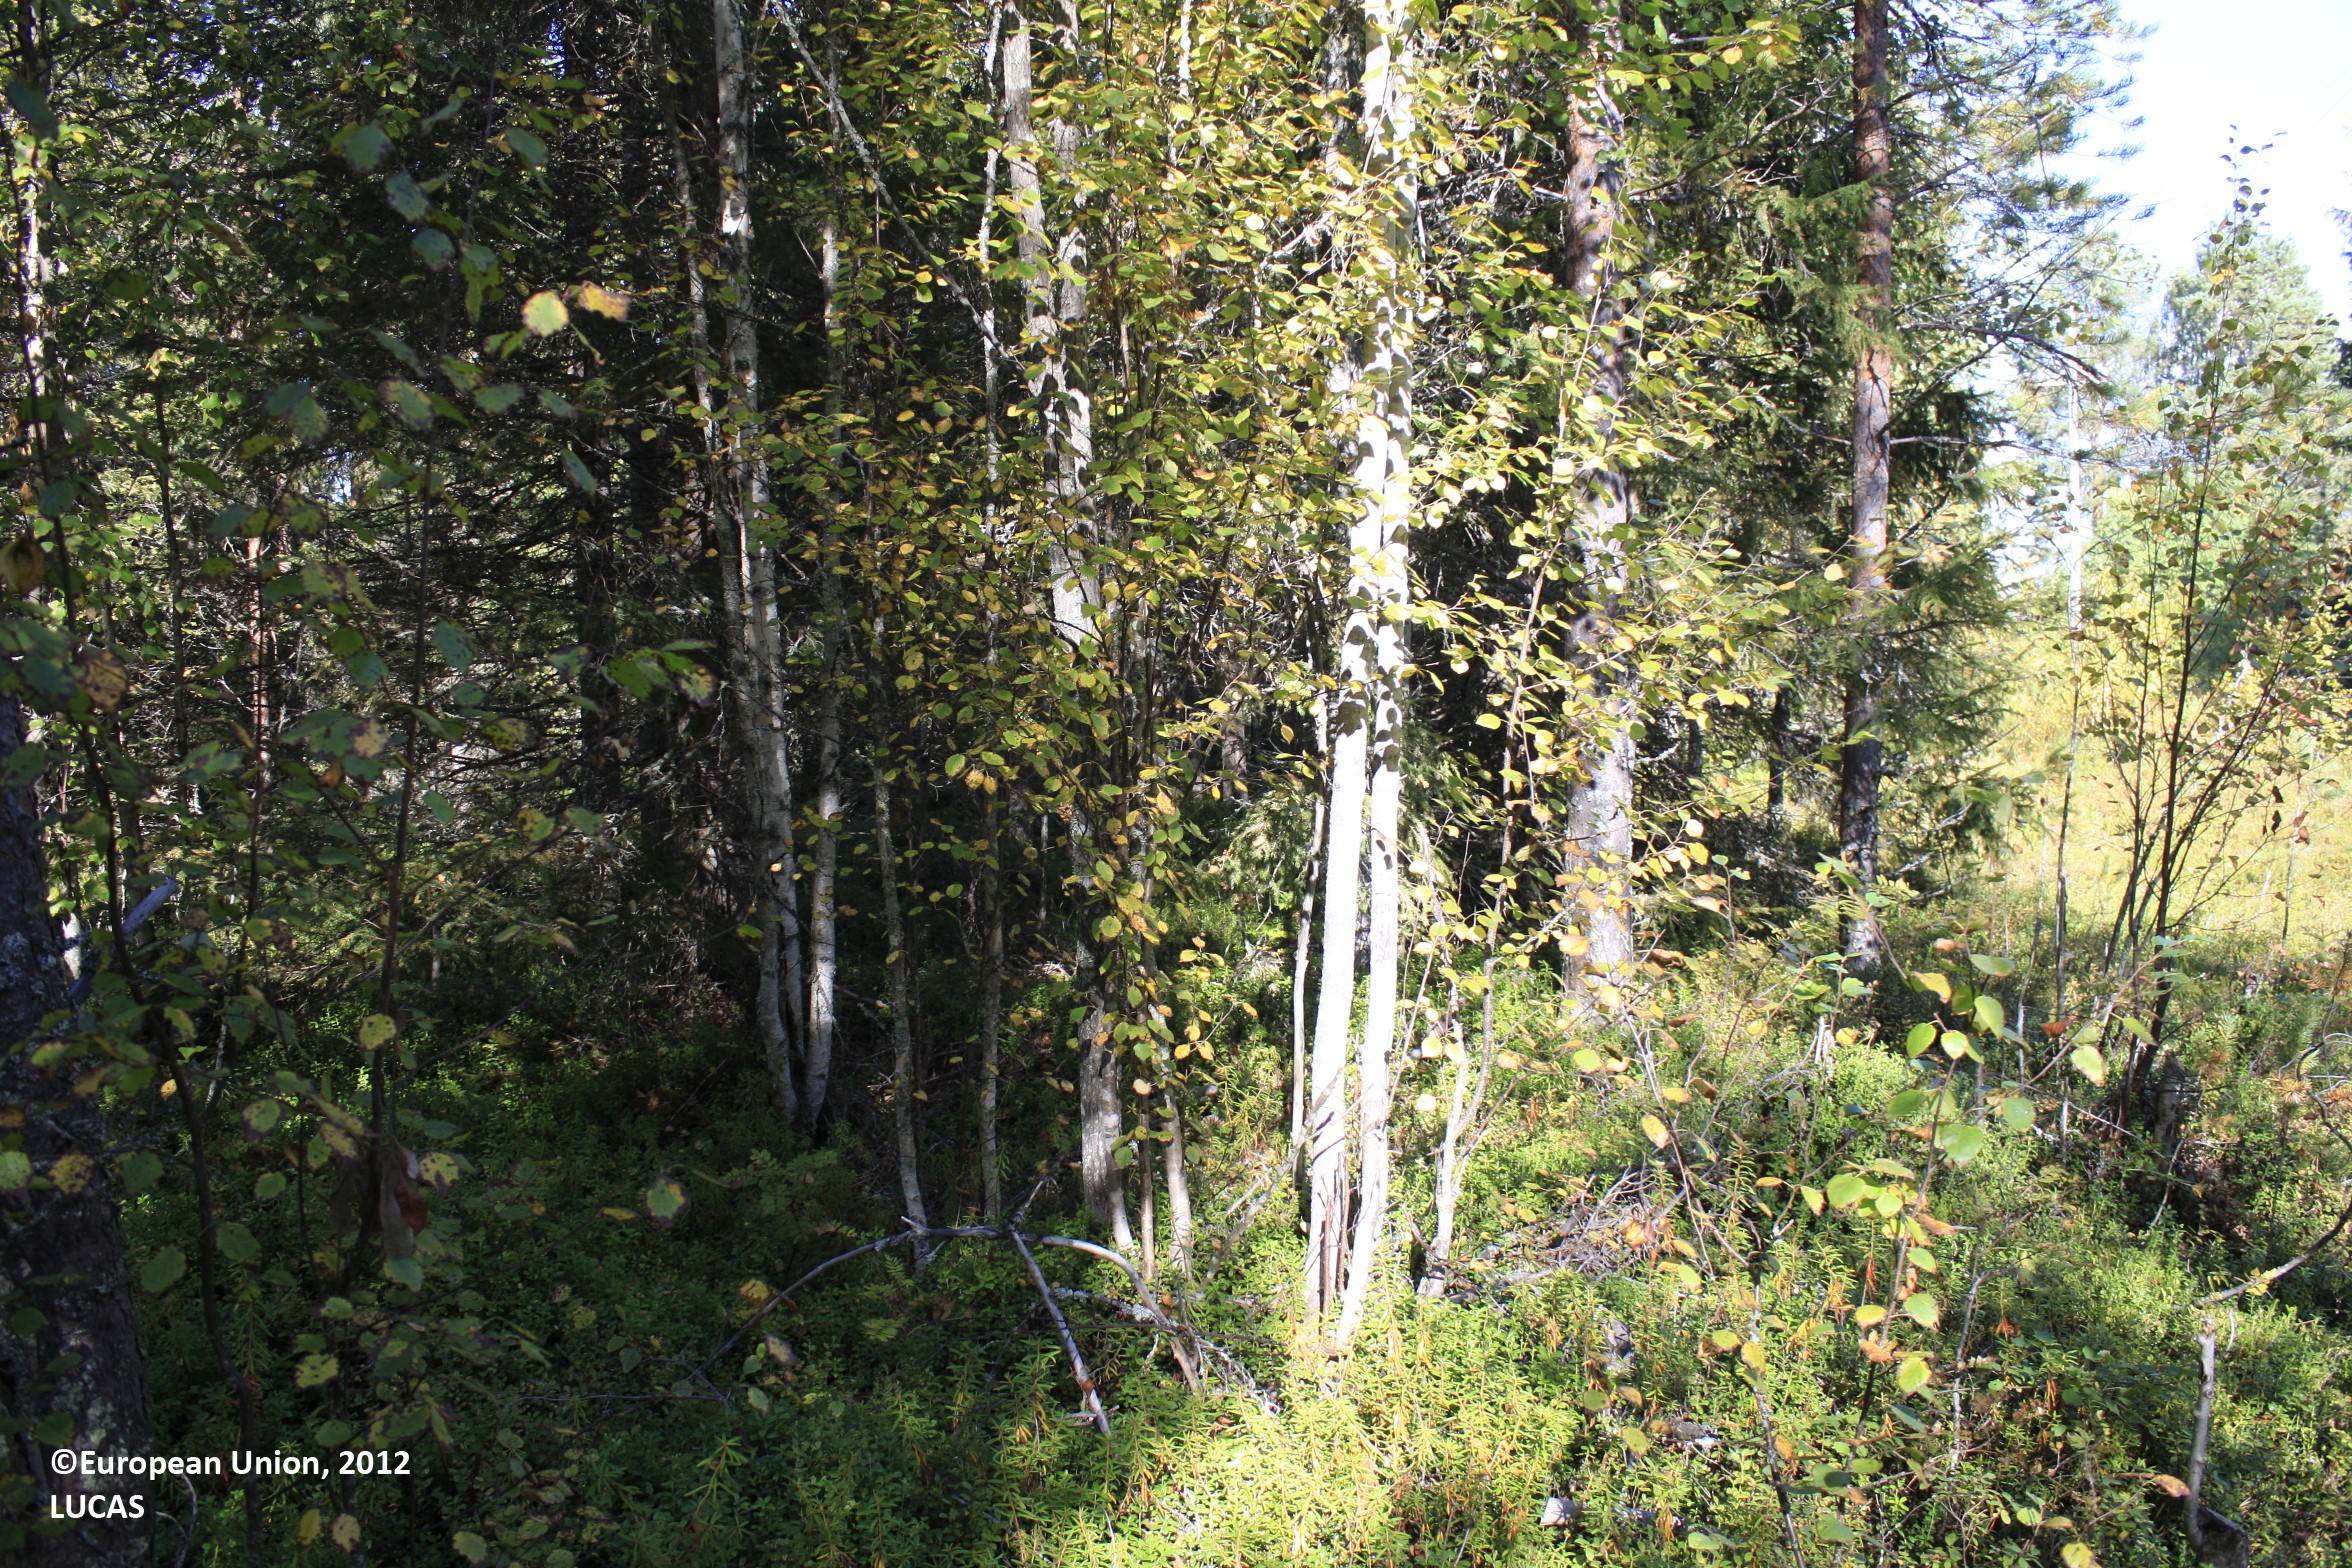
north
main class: Woodland
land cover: Pine dominated mixed woodland
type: boreal forest
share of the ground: 25 - 50 %
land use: Forestry
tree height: > 5 m
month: September
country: FI
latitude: 65.0660
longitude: 27.0224
